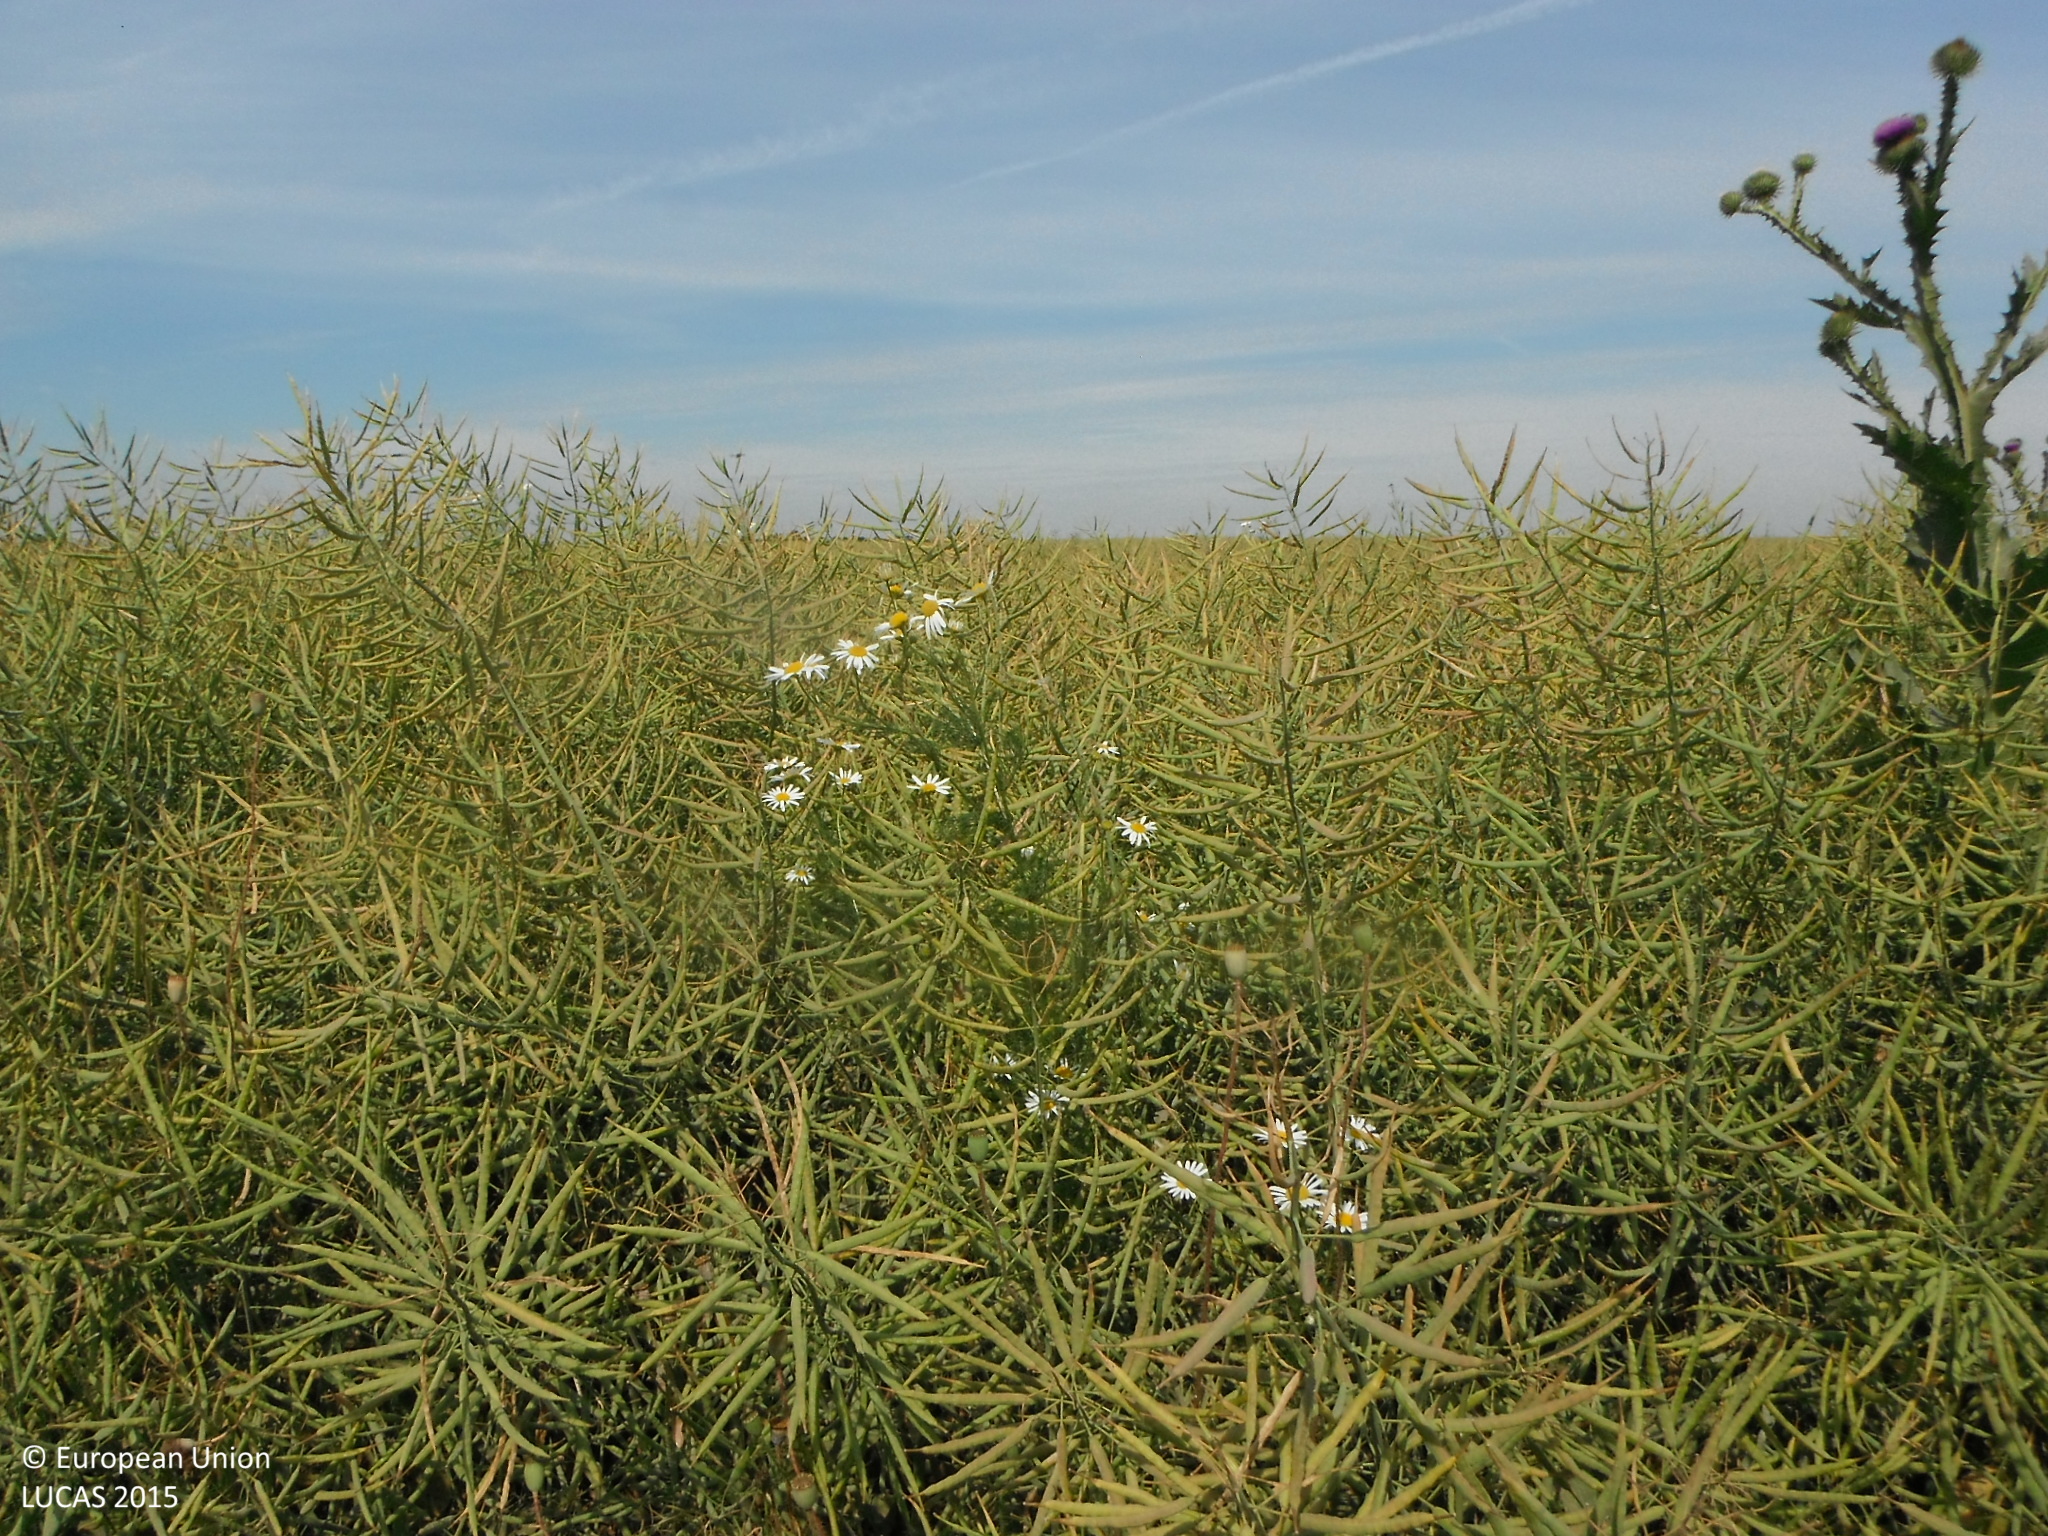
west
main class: Cropland
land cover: Rape and turnip rape
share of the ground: > 75 %
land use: Agriculture (excluding fallow land and kitchen gardens)
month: June
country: SK
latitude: 48.2637
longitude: 17.9201
